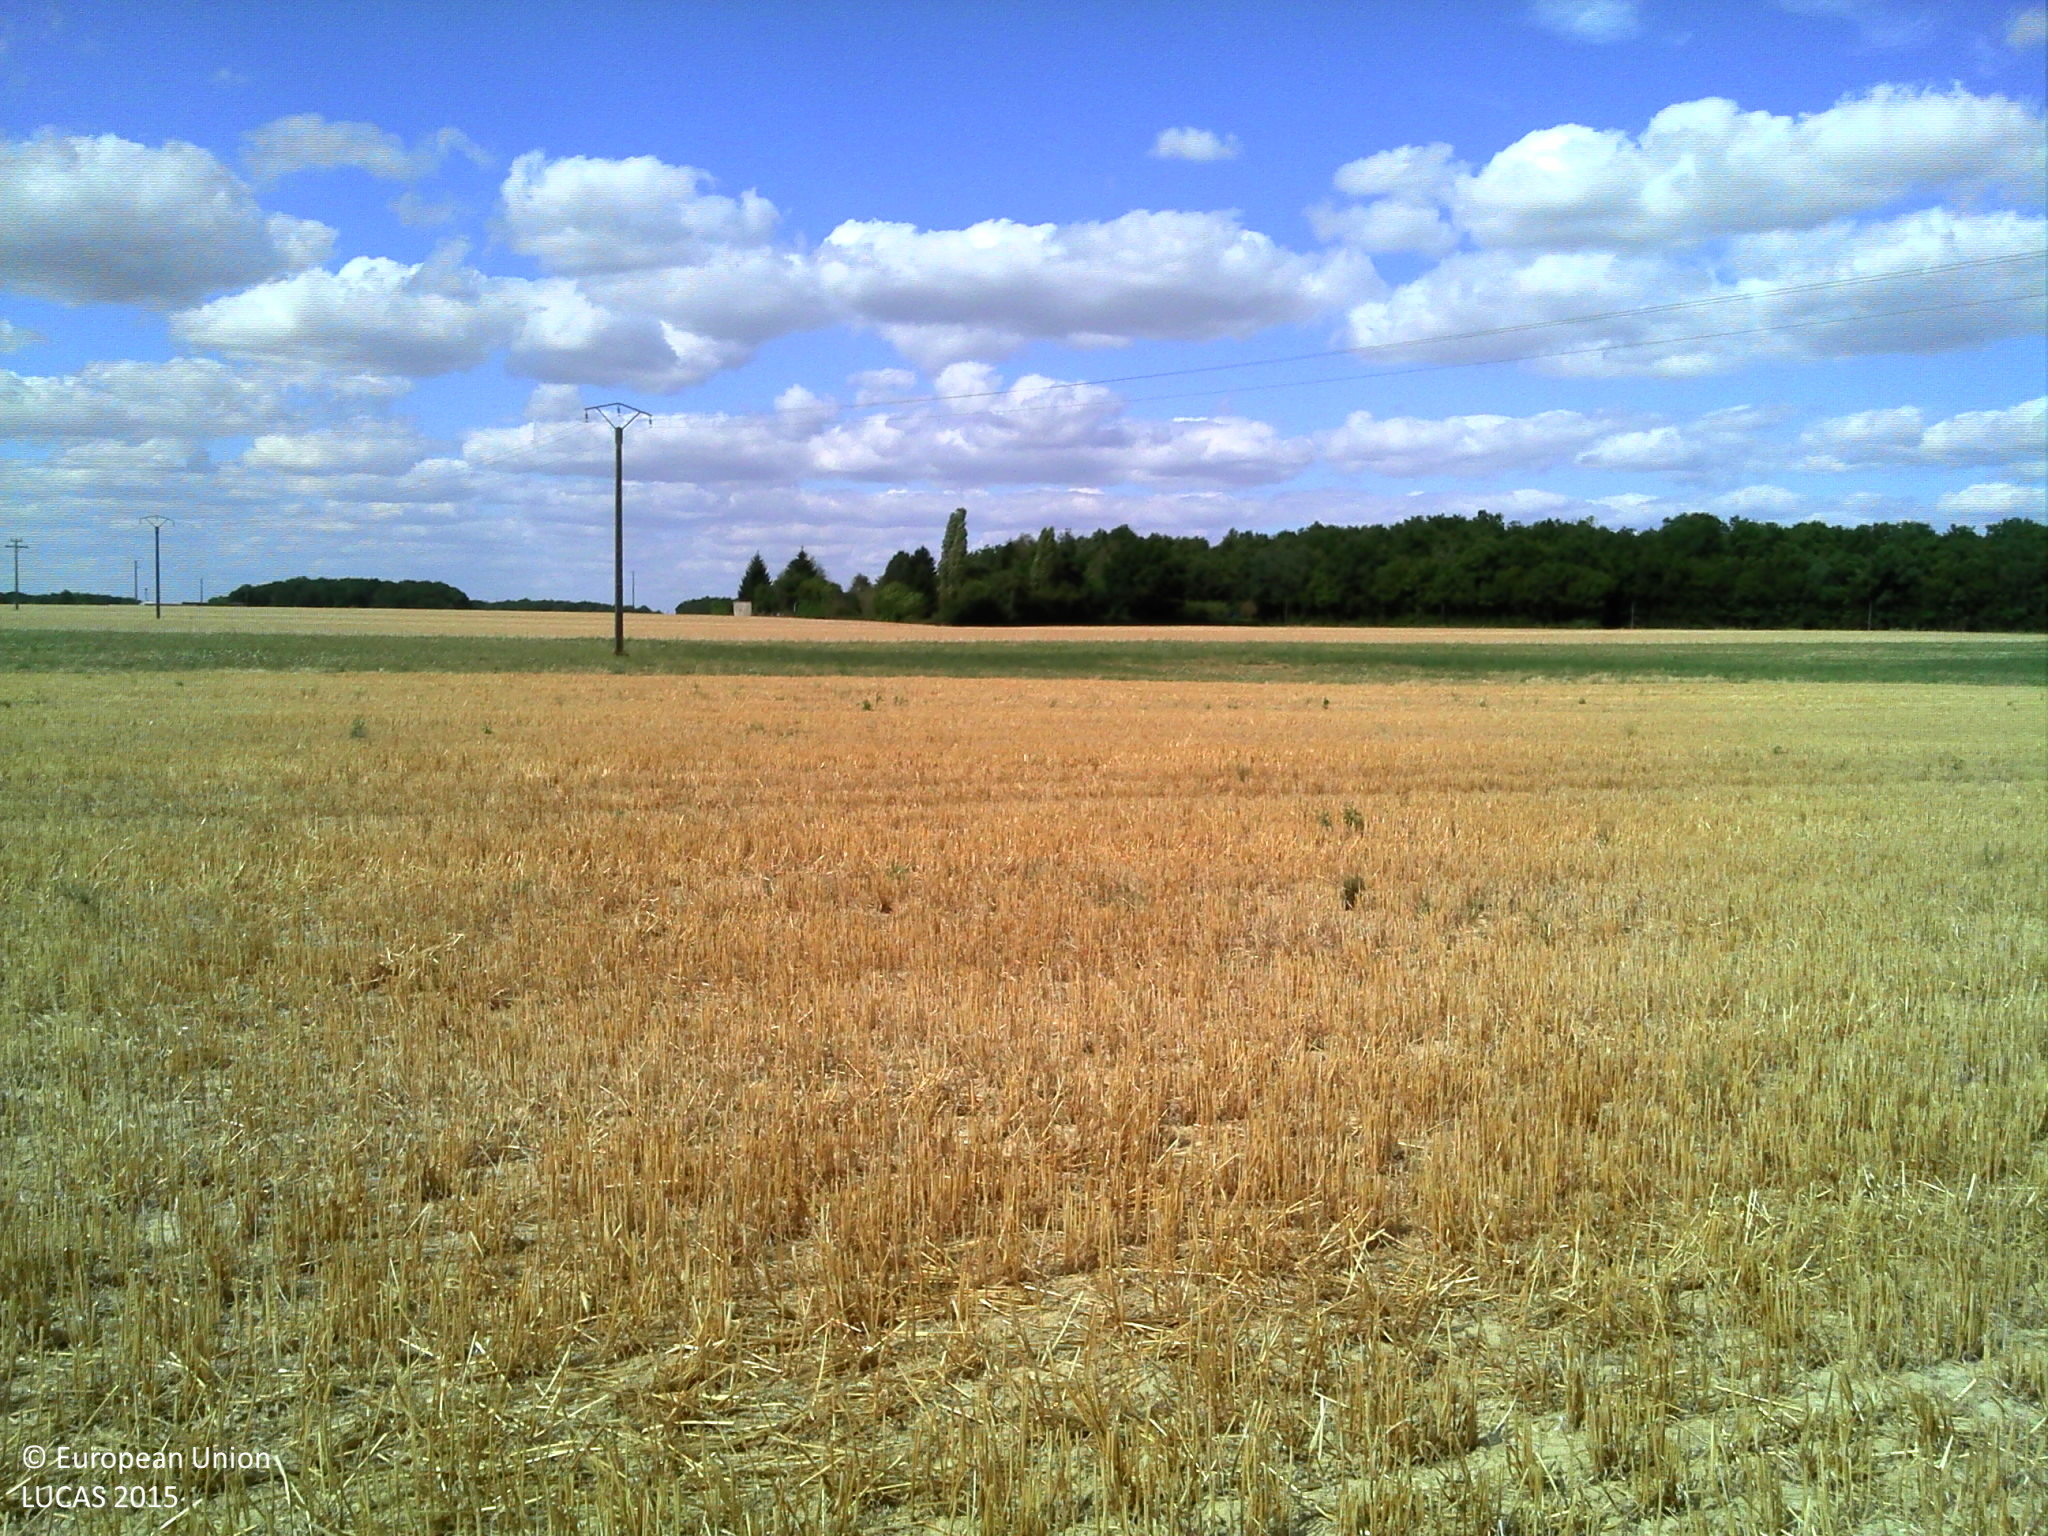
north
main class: Cropland
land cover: Barley
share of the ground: > 75 %
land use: Agriculture (excluding fallow land and kitchen gardens)
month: July
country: FR
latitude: 47.8063
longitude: 3.0636
